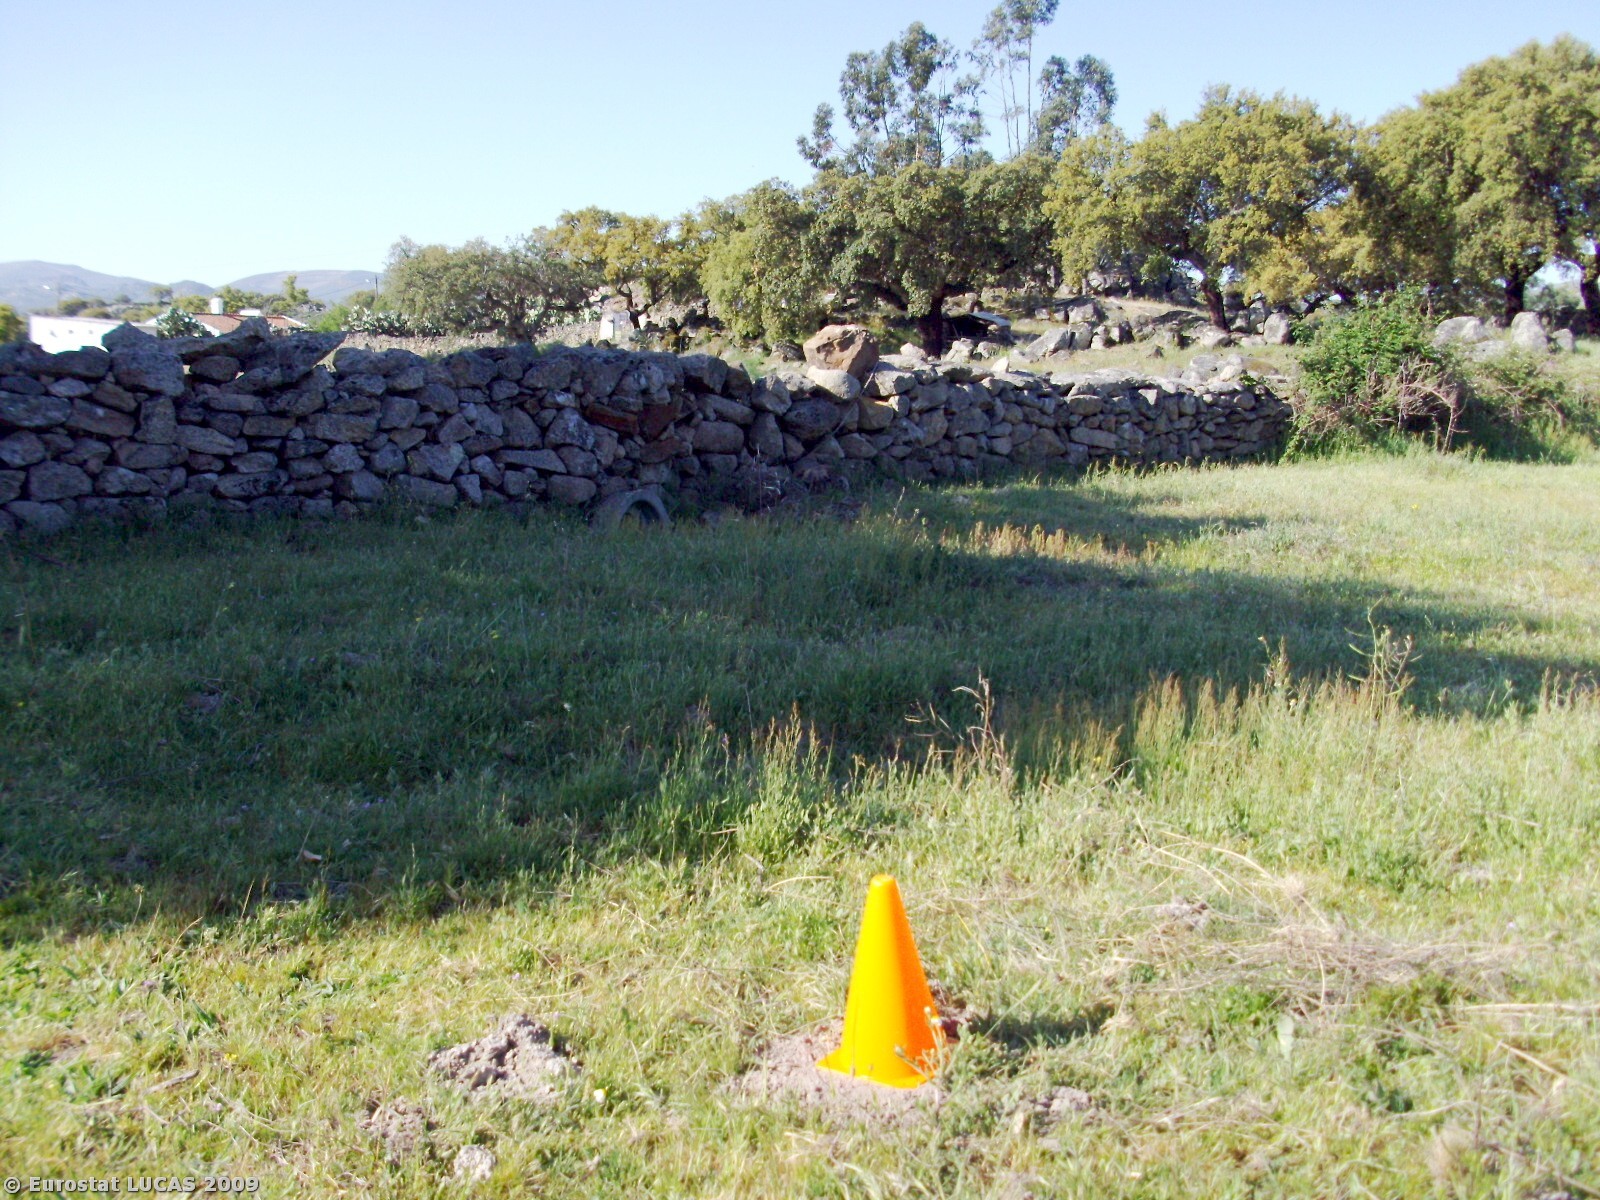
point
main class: Grassland
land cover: Spontaneously vegetated surfaces
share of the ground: 25 - 50 %
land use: Fallow land
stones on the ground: < 10 %
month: May
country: PT
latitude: 39.4338
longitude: -7.3172
